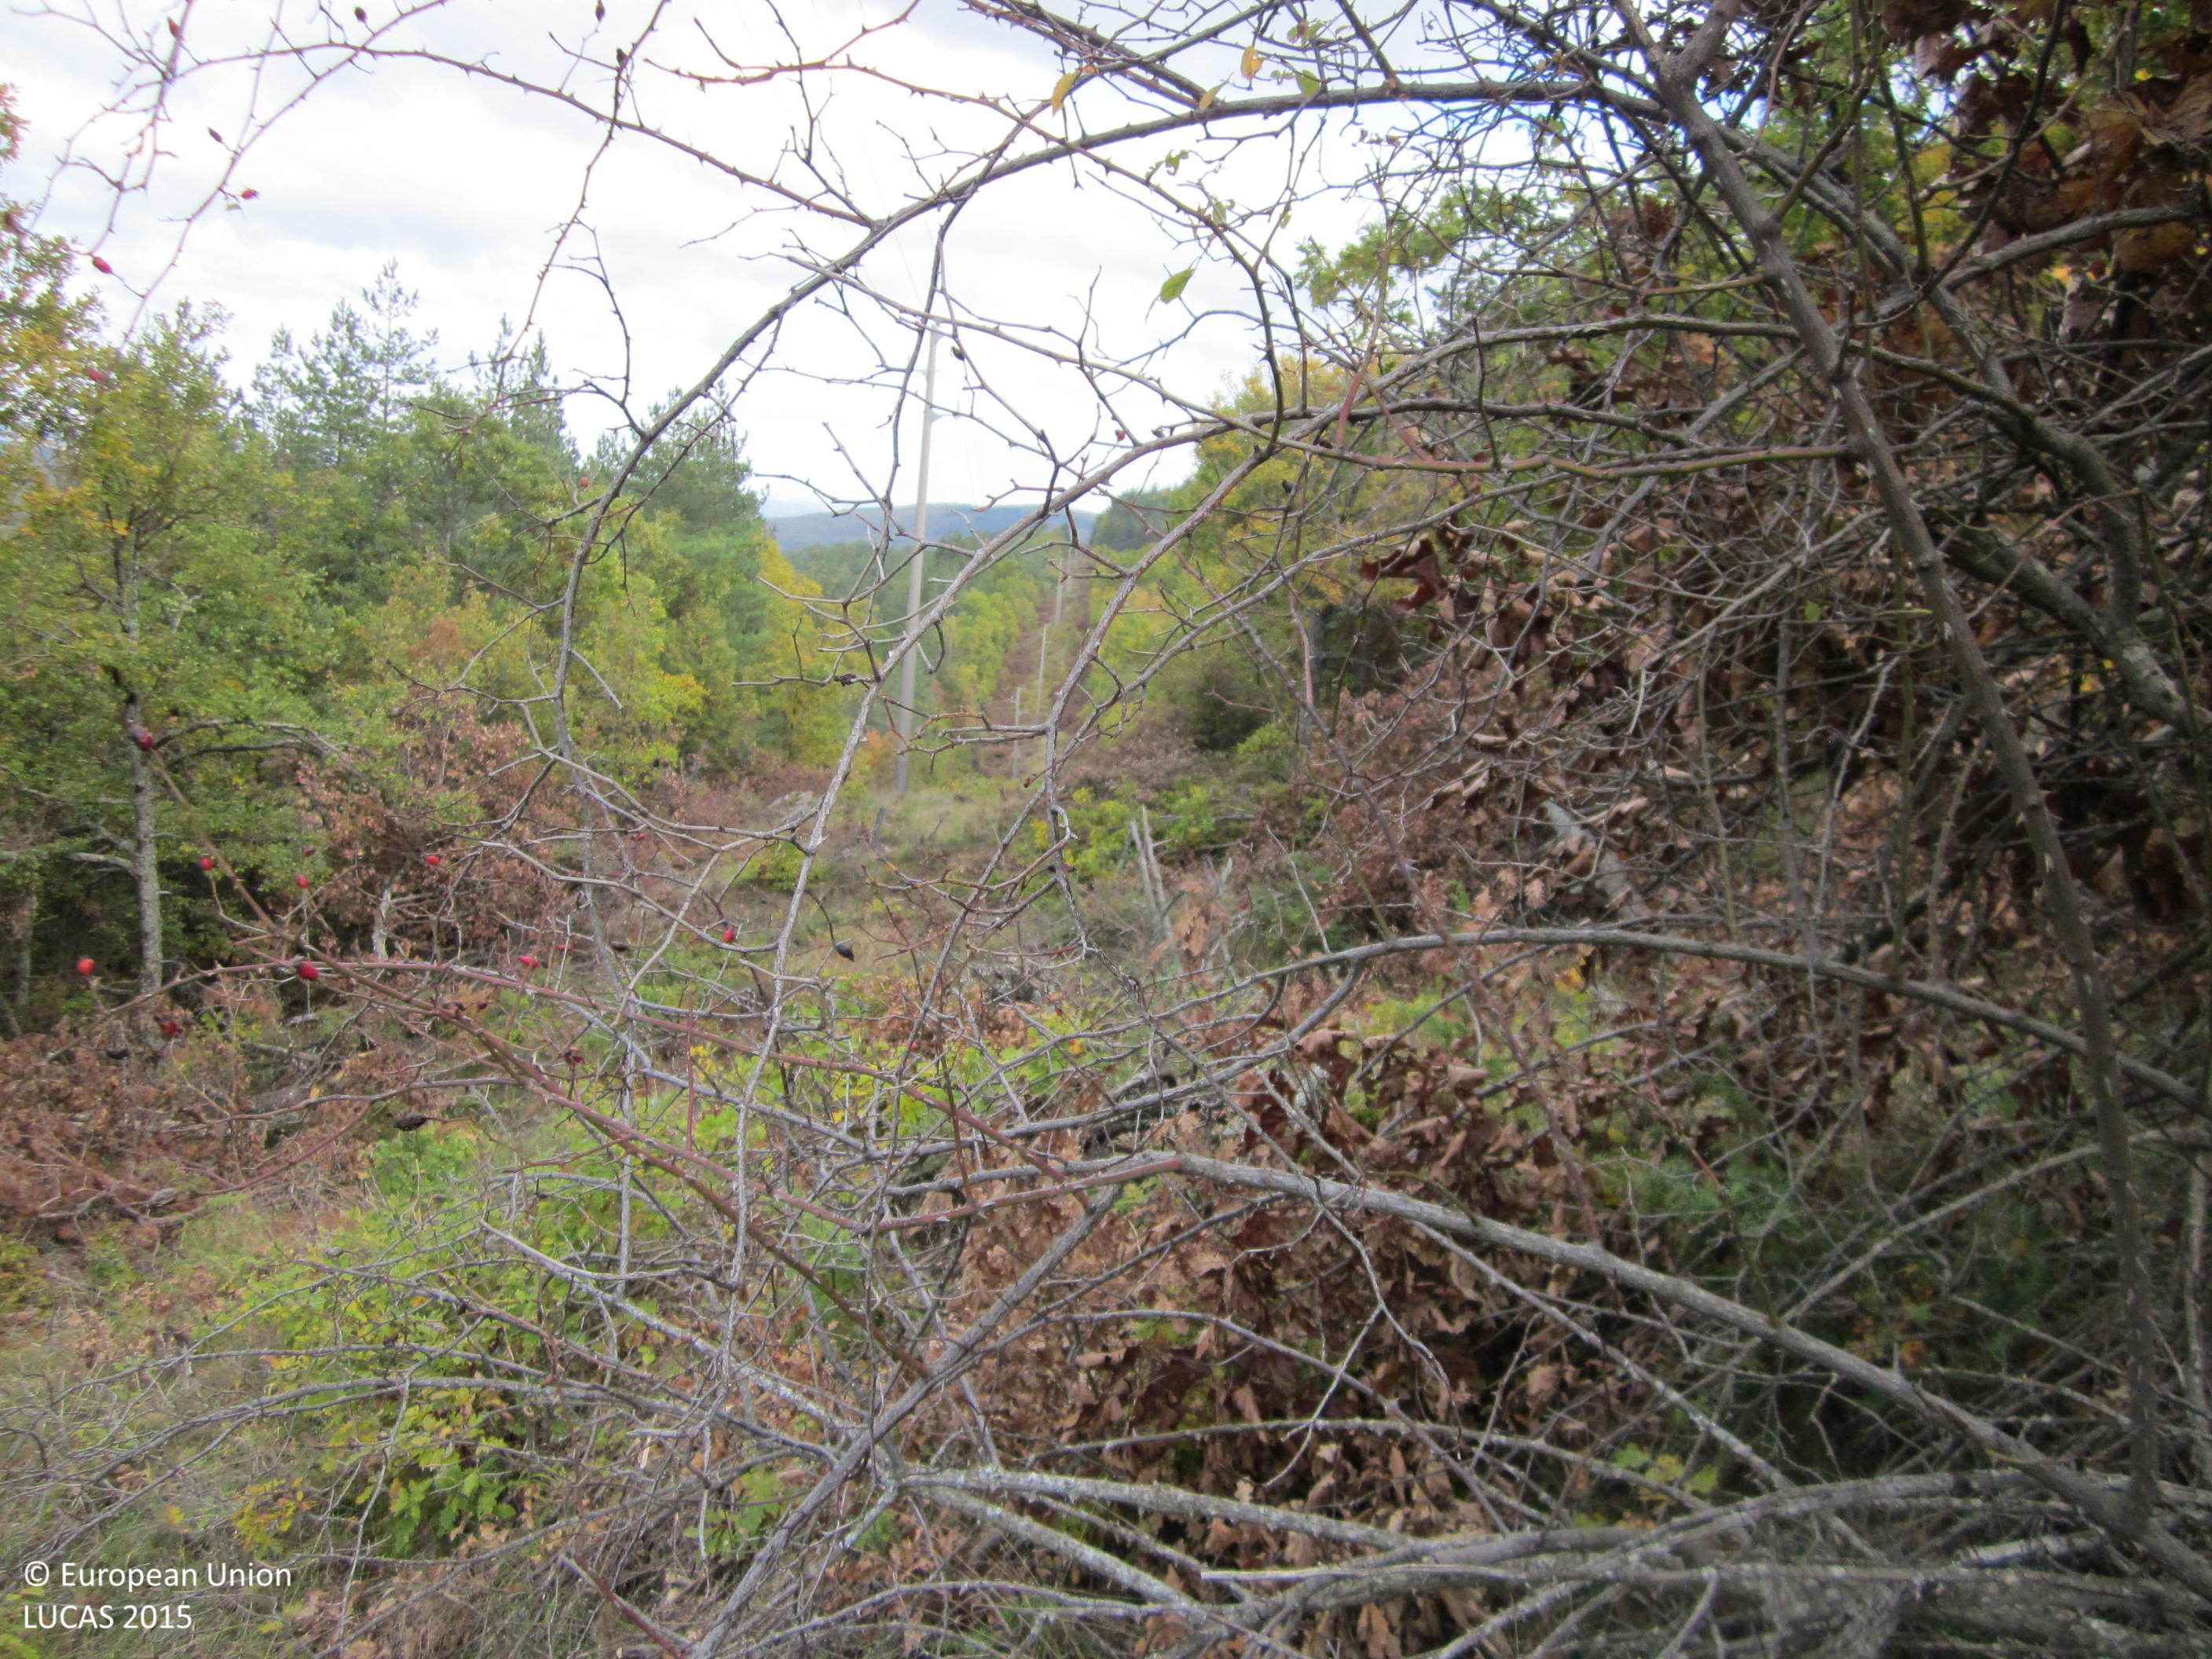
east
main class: Woodland
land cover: Broadleaved woodland
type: mesophytic deciduous forest
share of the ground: 50 - 75 %
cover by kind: broadleaved forest trees 50 %, herbaceous plants 25 %, shrubs 20 %, coniferous forest trees 5 %
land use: Forestry
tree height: > 5 m
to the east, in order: Broadleaved woodland; Other mixed woodland; Rivers and streams; Other mixed woodland
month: November
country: BG
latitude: 41.3770
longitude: 25.8581
